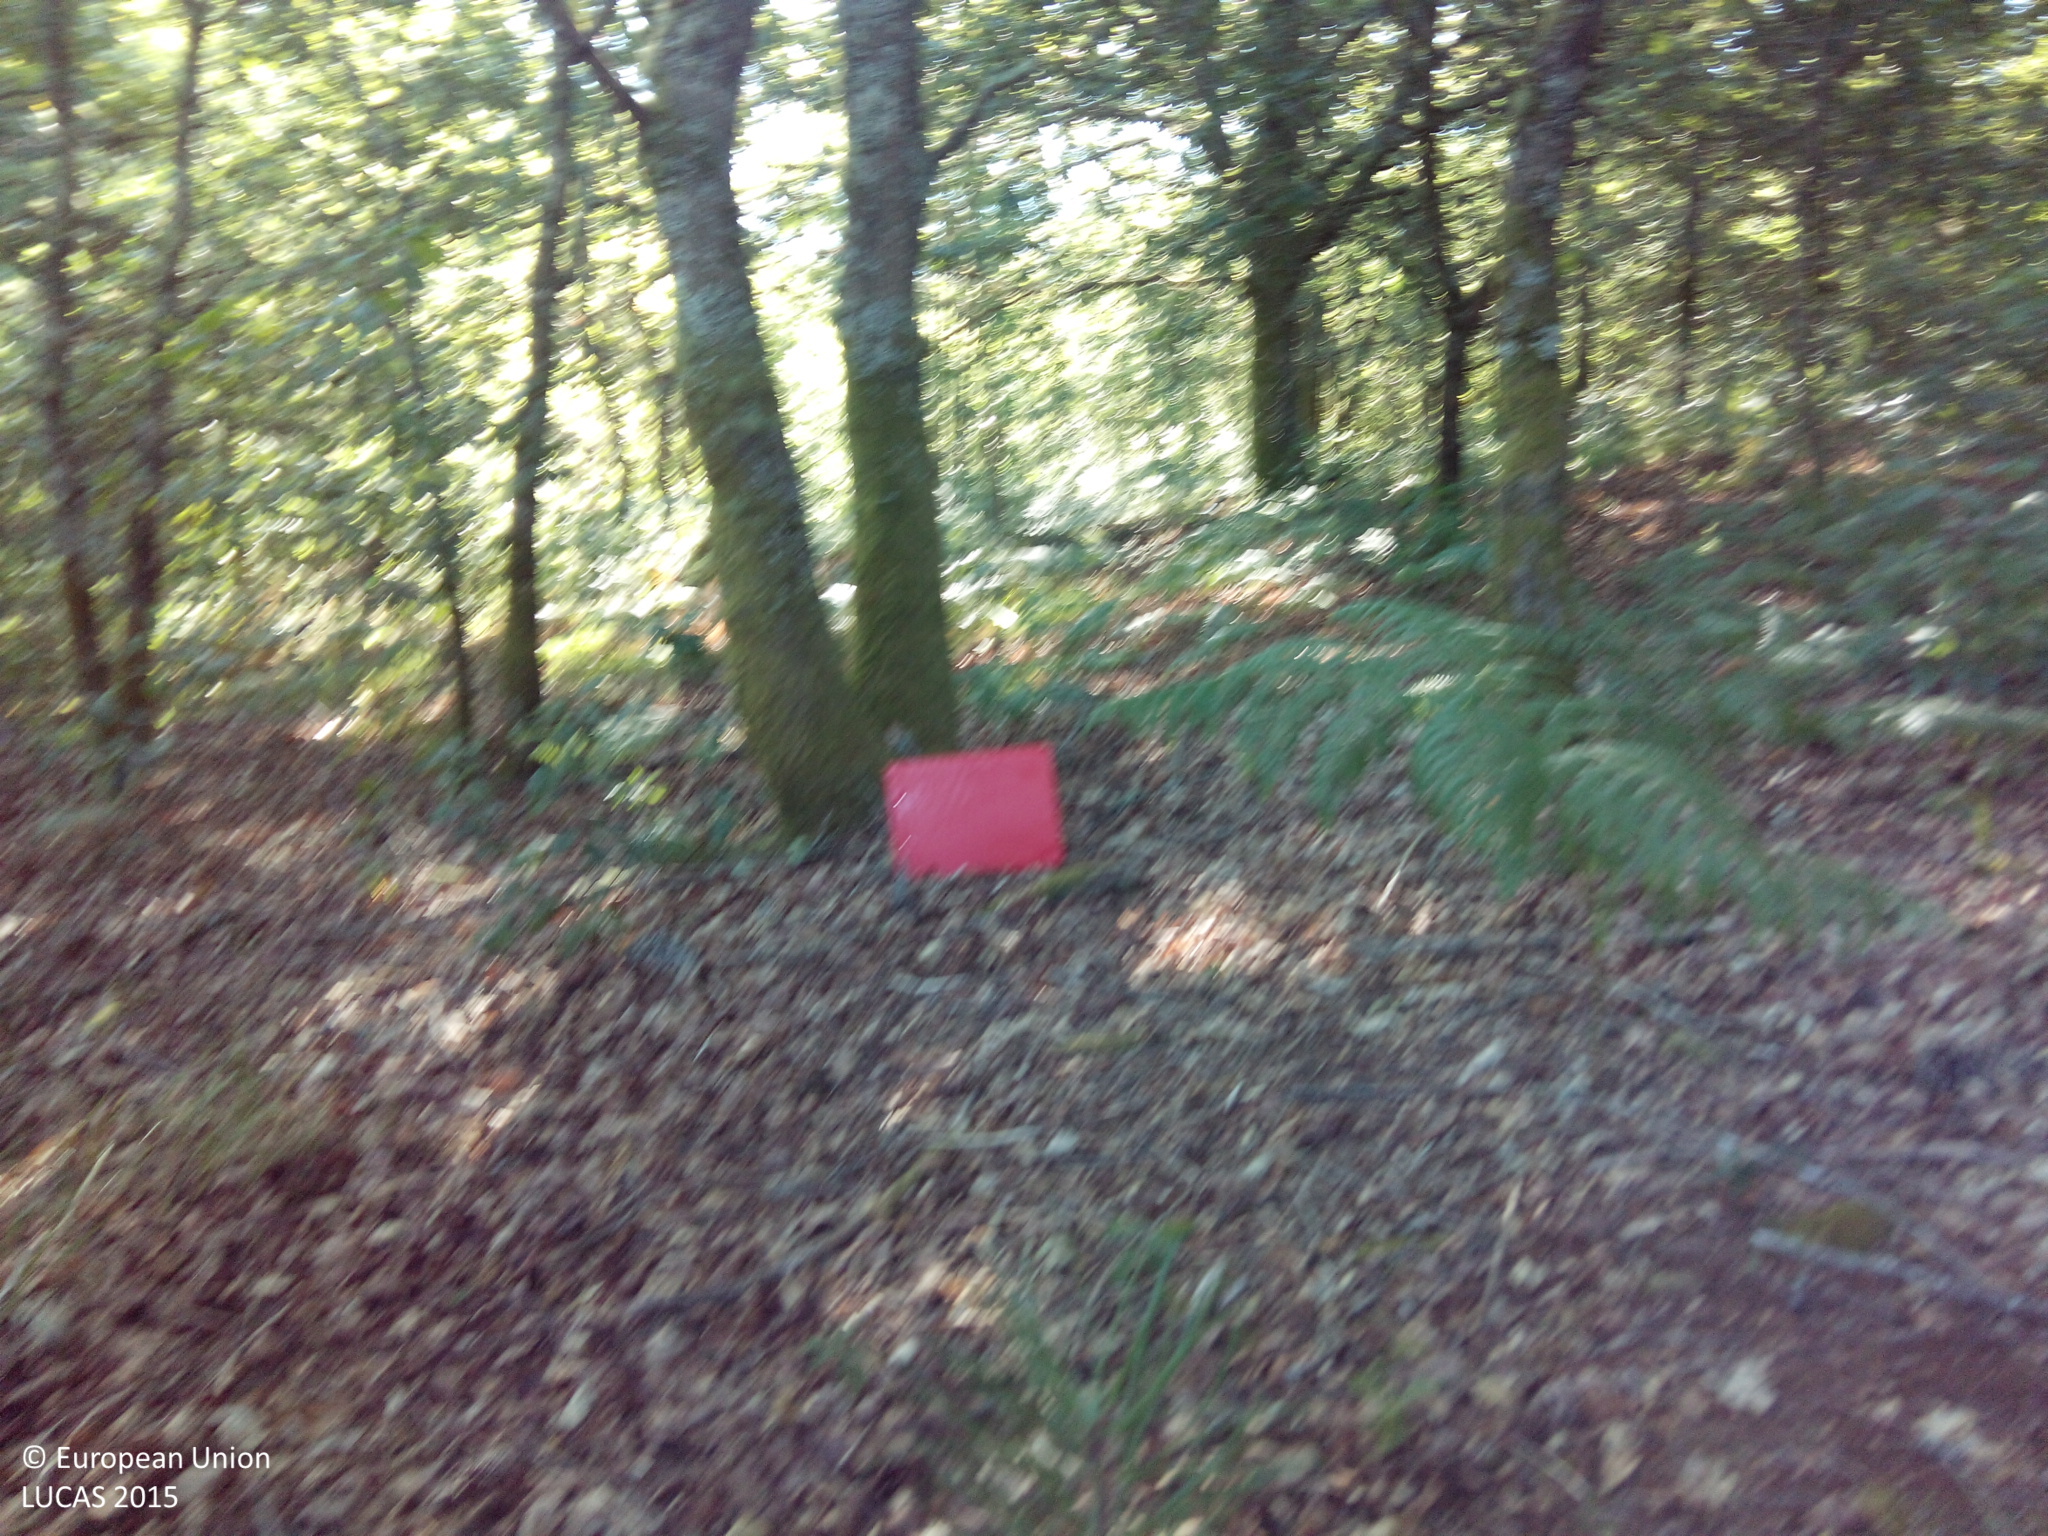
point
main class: Woodland
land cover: Broadleaved woodland
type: acidophilous oak and oak-birch forest
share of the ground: > 75 %
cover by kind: broadleaved forest trees 75 %, herbaceous plants 15 %, shrubs 10 %
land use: Forestry
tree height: > 5 m
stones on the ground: < 10 %
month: June
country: ES
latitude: 42.5230
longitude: -8.3911
